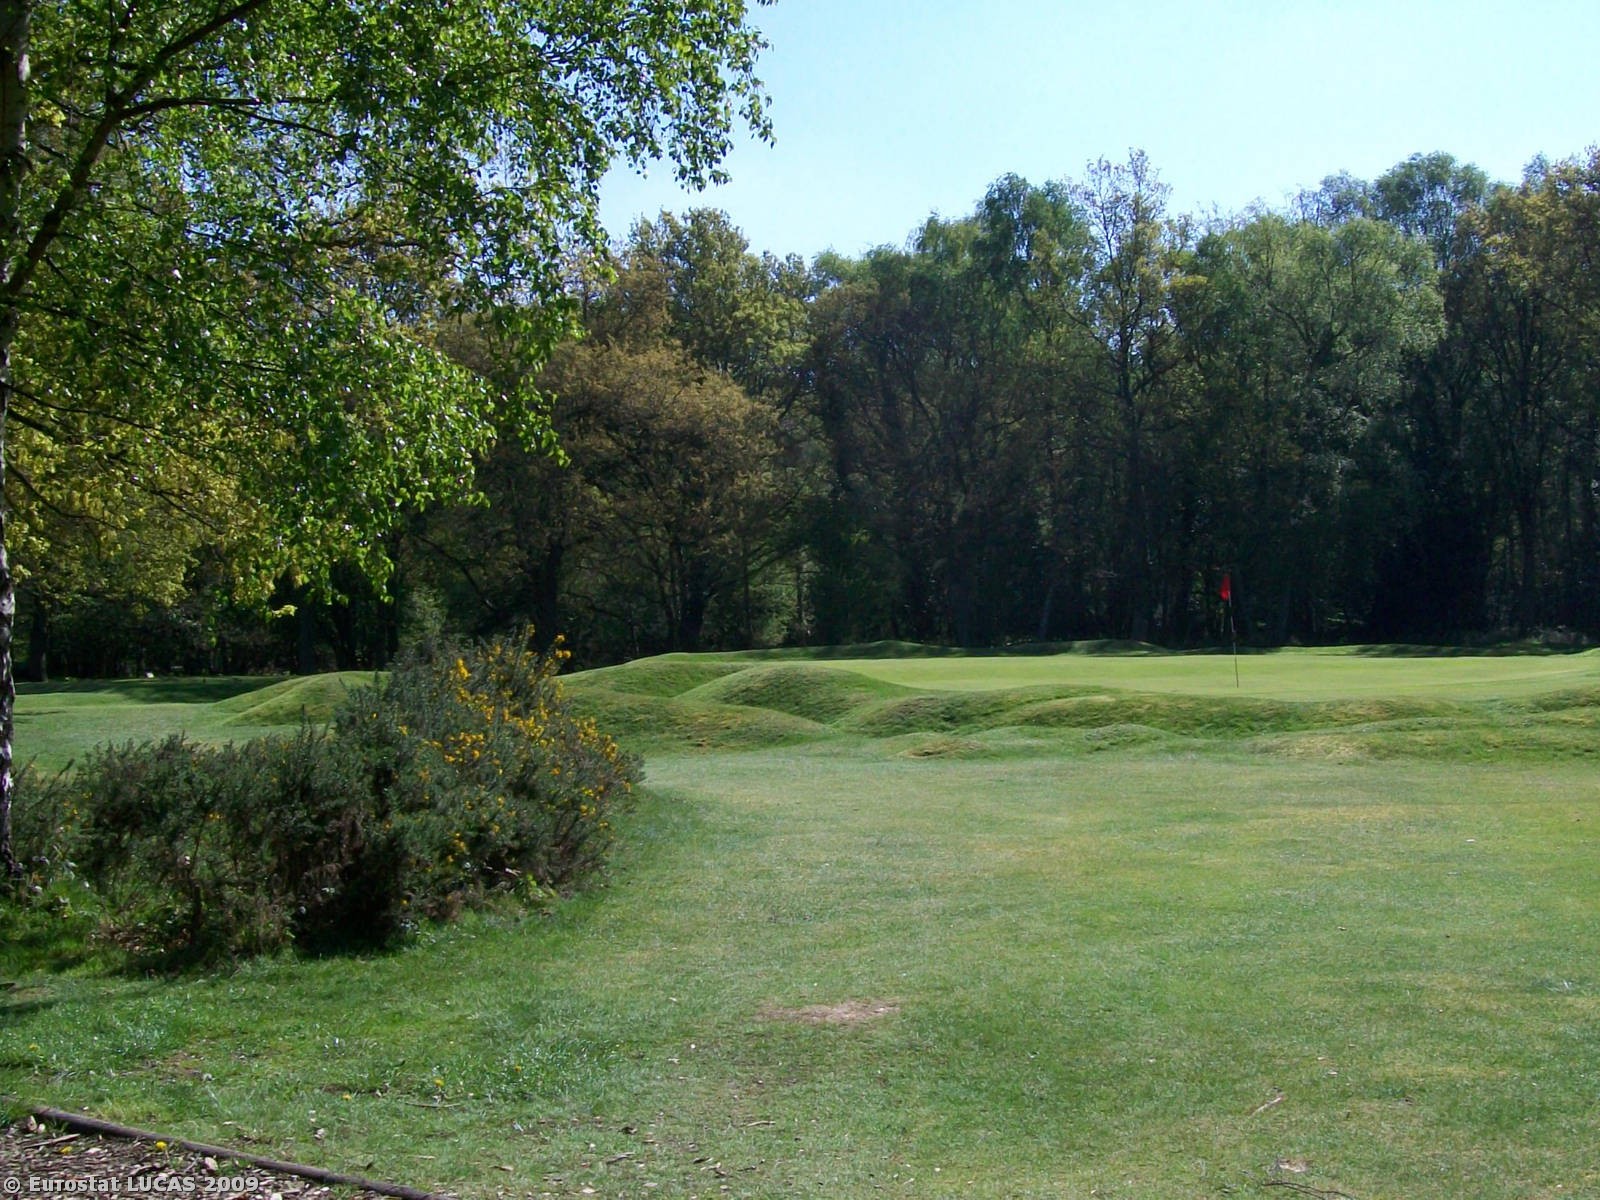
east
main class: Woodland
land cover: Broadleaved woodland
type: mesophytic deciduous forest
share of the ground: > 75 %
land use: Sport
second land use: Community services
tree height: > 5 m
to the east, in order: Broadleaved woodland; Grassland without tree/shrub cover; Broadleaved woodland; Paved roads, cycling and walking lanes; Broadleaved woodland; Tracks; Broadleaved woodland
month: April
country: GB
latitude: 51.7793
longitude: -0.5474
